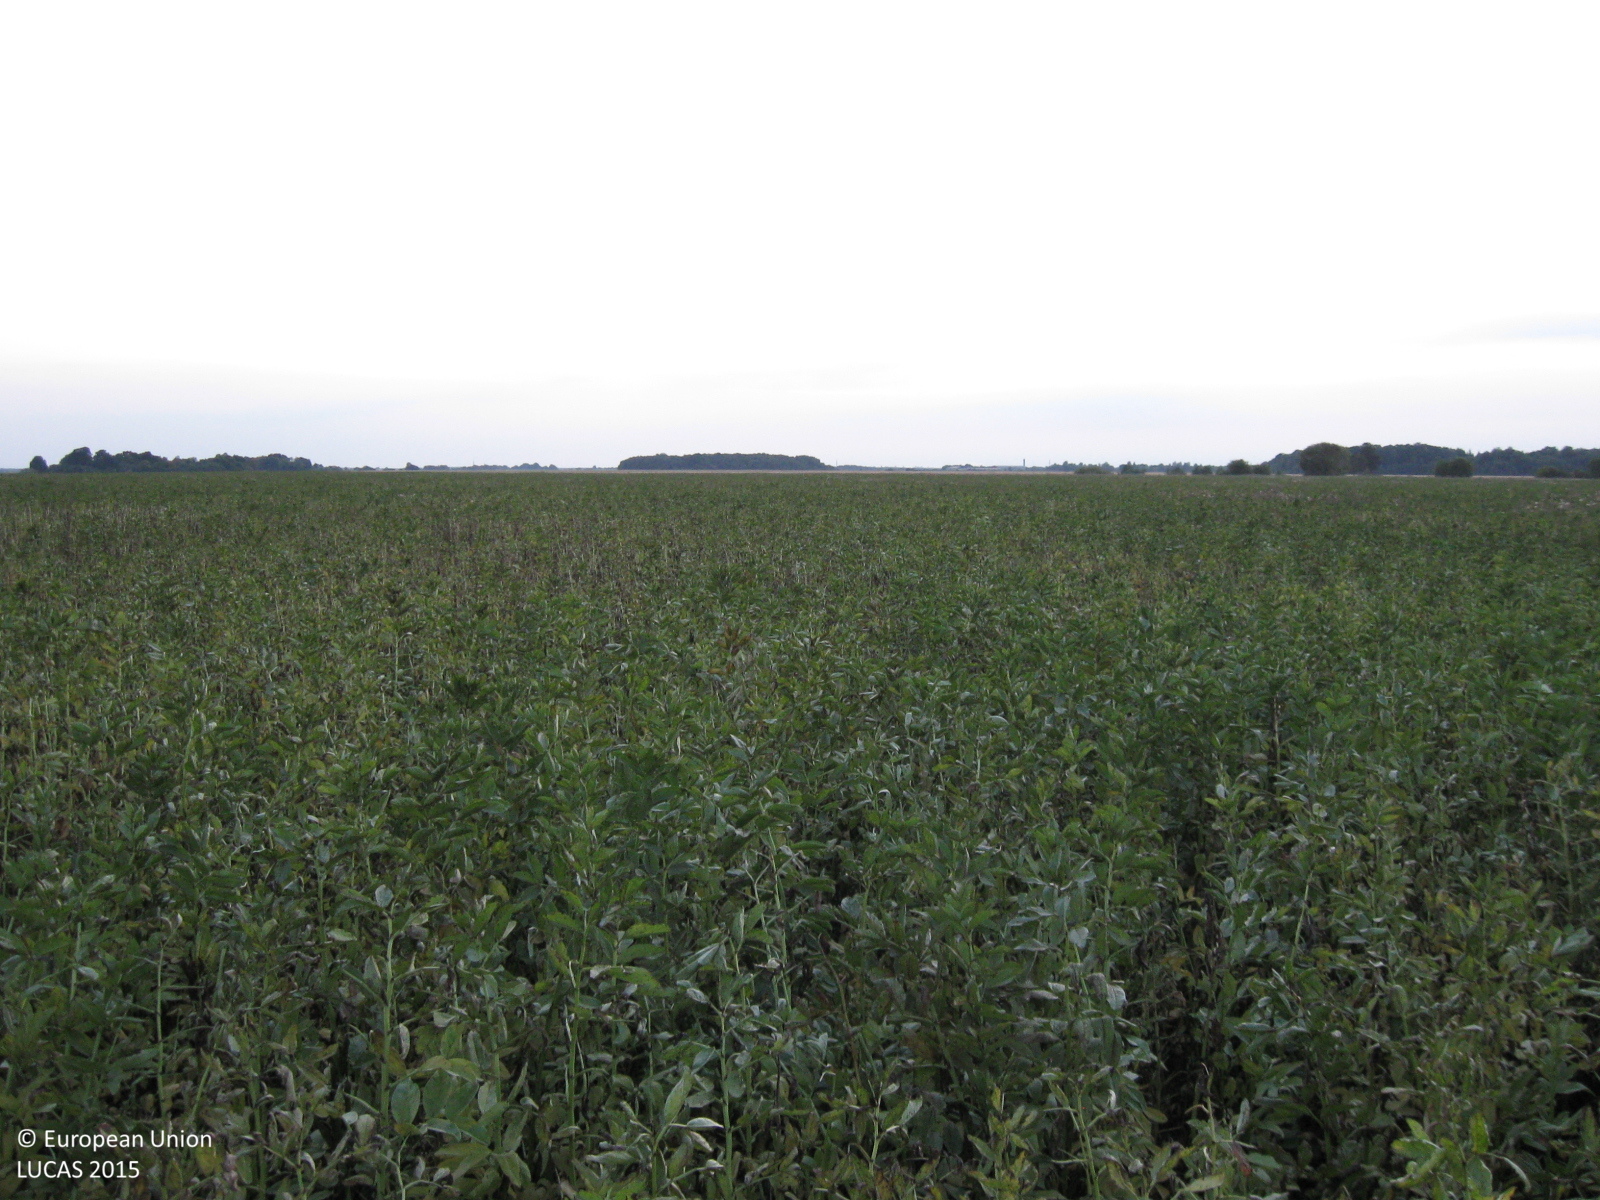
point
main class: Cropland
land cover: Dry pulses
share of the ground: > 75 %
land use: Agriculture (excluding fallow land and kitchen gardens)
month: August
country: LT
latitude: 55.1513
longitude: 22.8893
